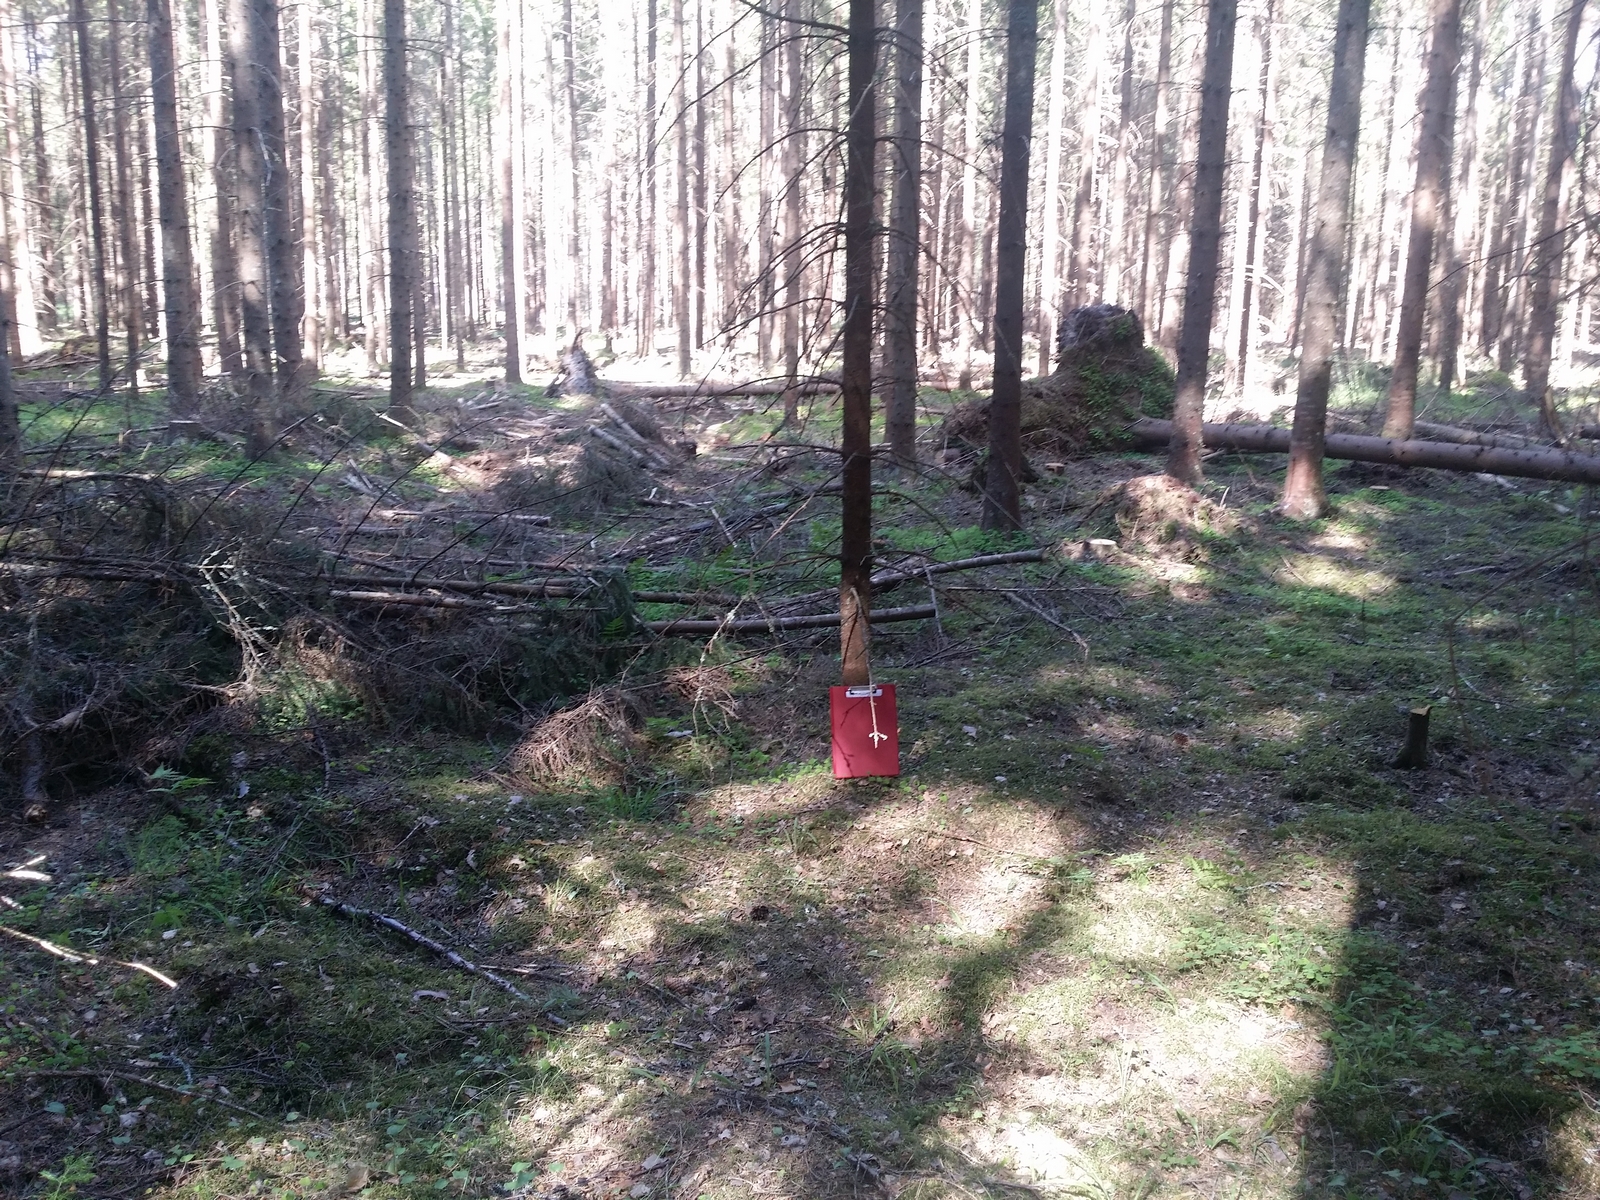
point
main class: Woodland
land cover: Spruce dominated coniferous woodland
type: hemiboreal forest and nemoral coniferous forest and mixed broadleaved-coniferous forest
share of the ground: > 75 %
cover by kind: coniferous forest trees 75 %, lichens and mosses 15 %, herbaceous plants 10 %
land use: Forestry
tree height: > 5 m
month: June
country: LV
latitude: 57.3258
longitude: 26.4343
